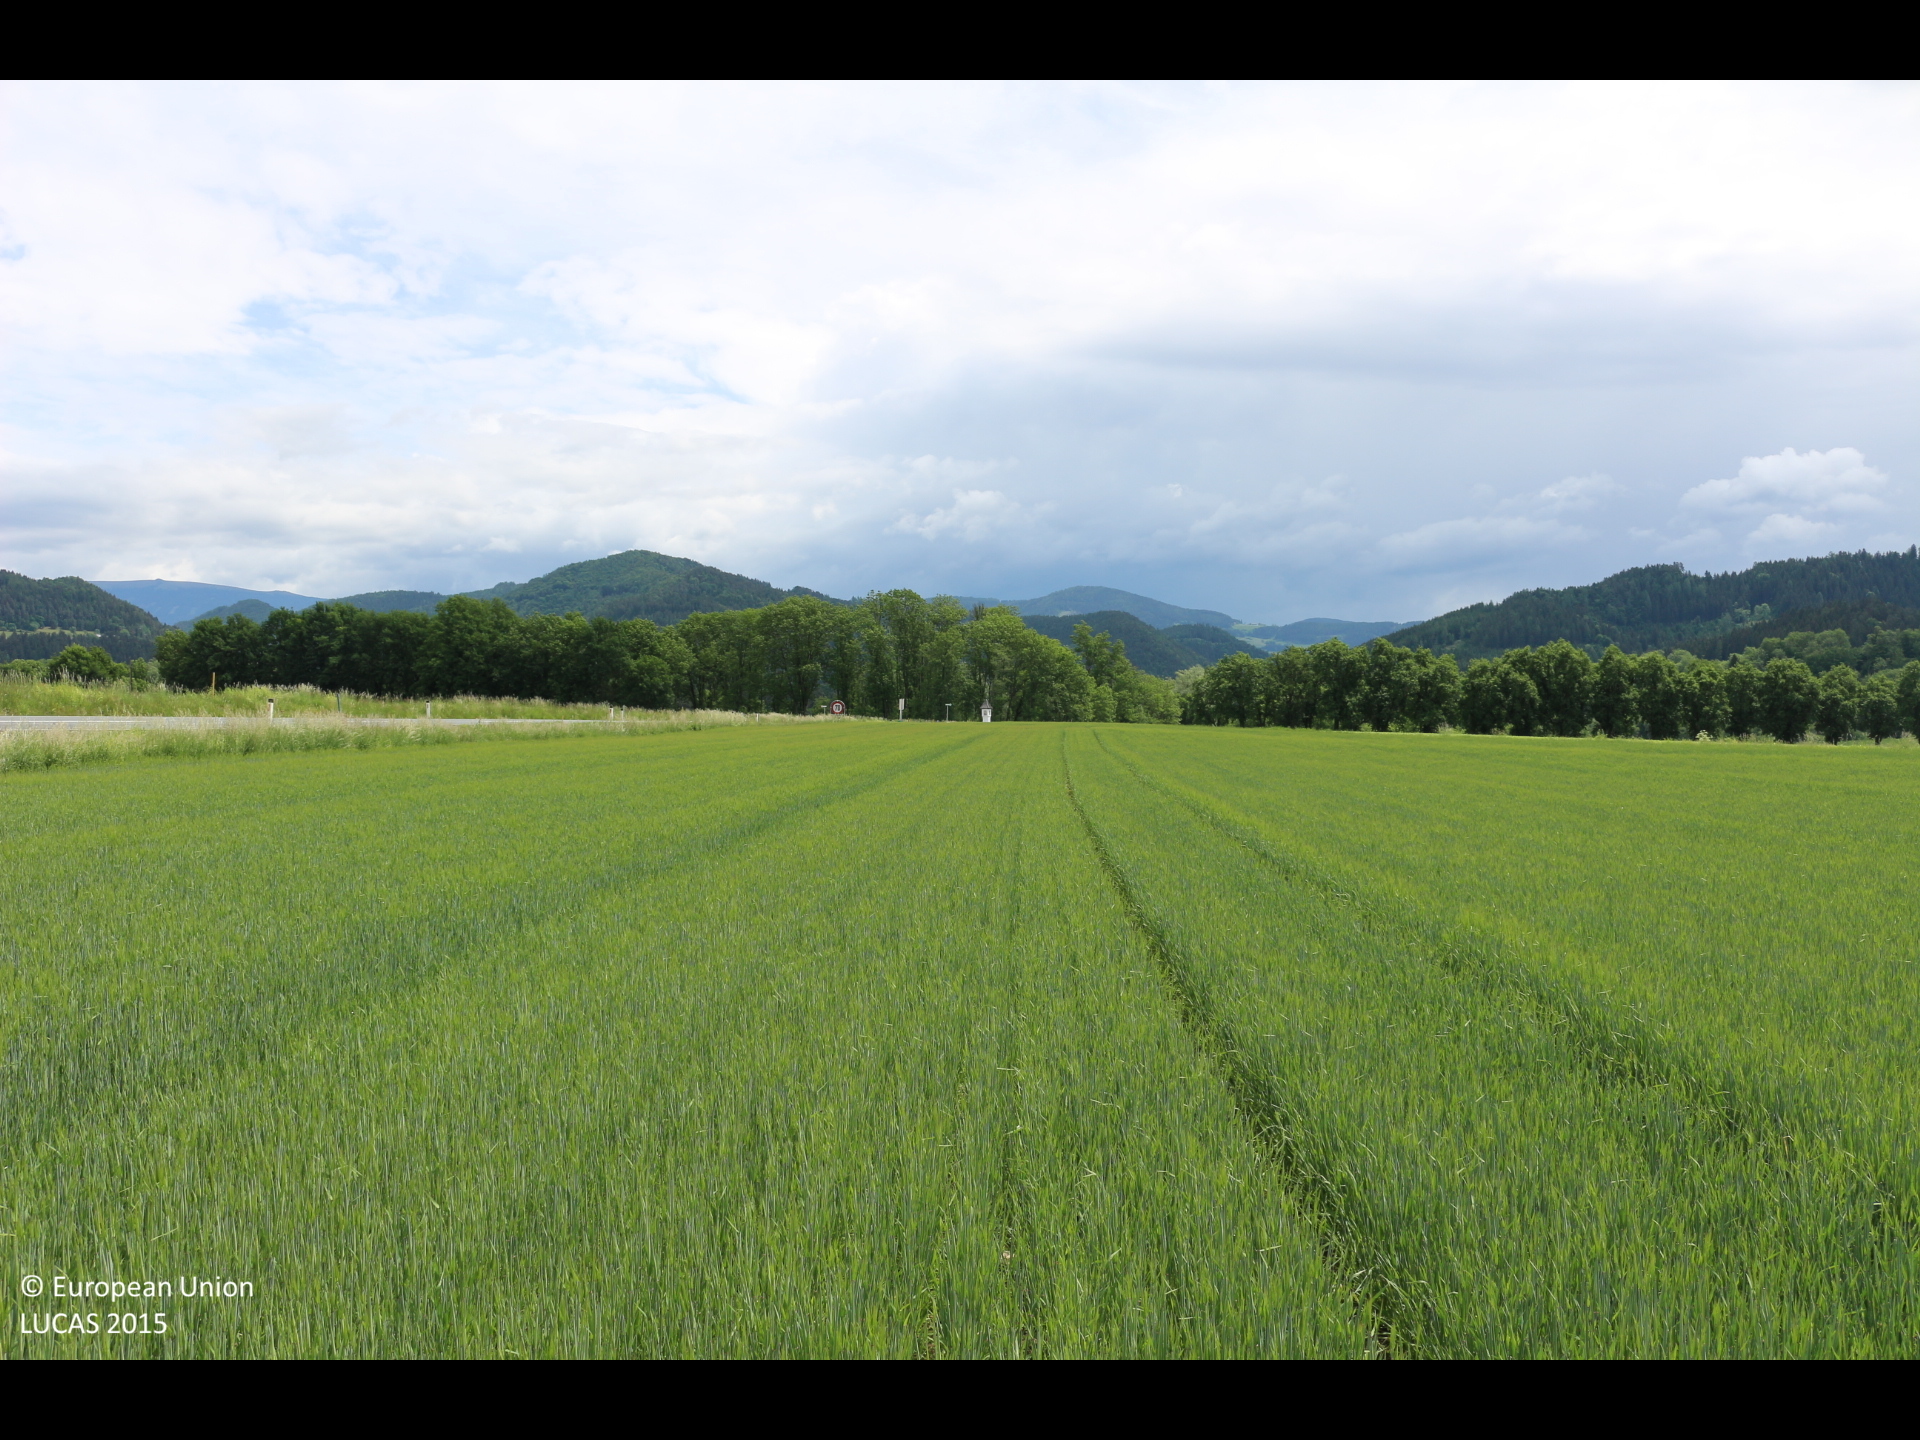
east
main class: Cropland
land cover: Triticale
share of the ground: > 75 %
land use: Agriculture (excluding fallow land and kitchen gardens)
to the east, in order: Triticale; Grass margins; Paved roads, cycling and walking lanes; Grass margins; Maize
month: May
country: AT
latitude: 46.7631
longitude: 14.4627
